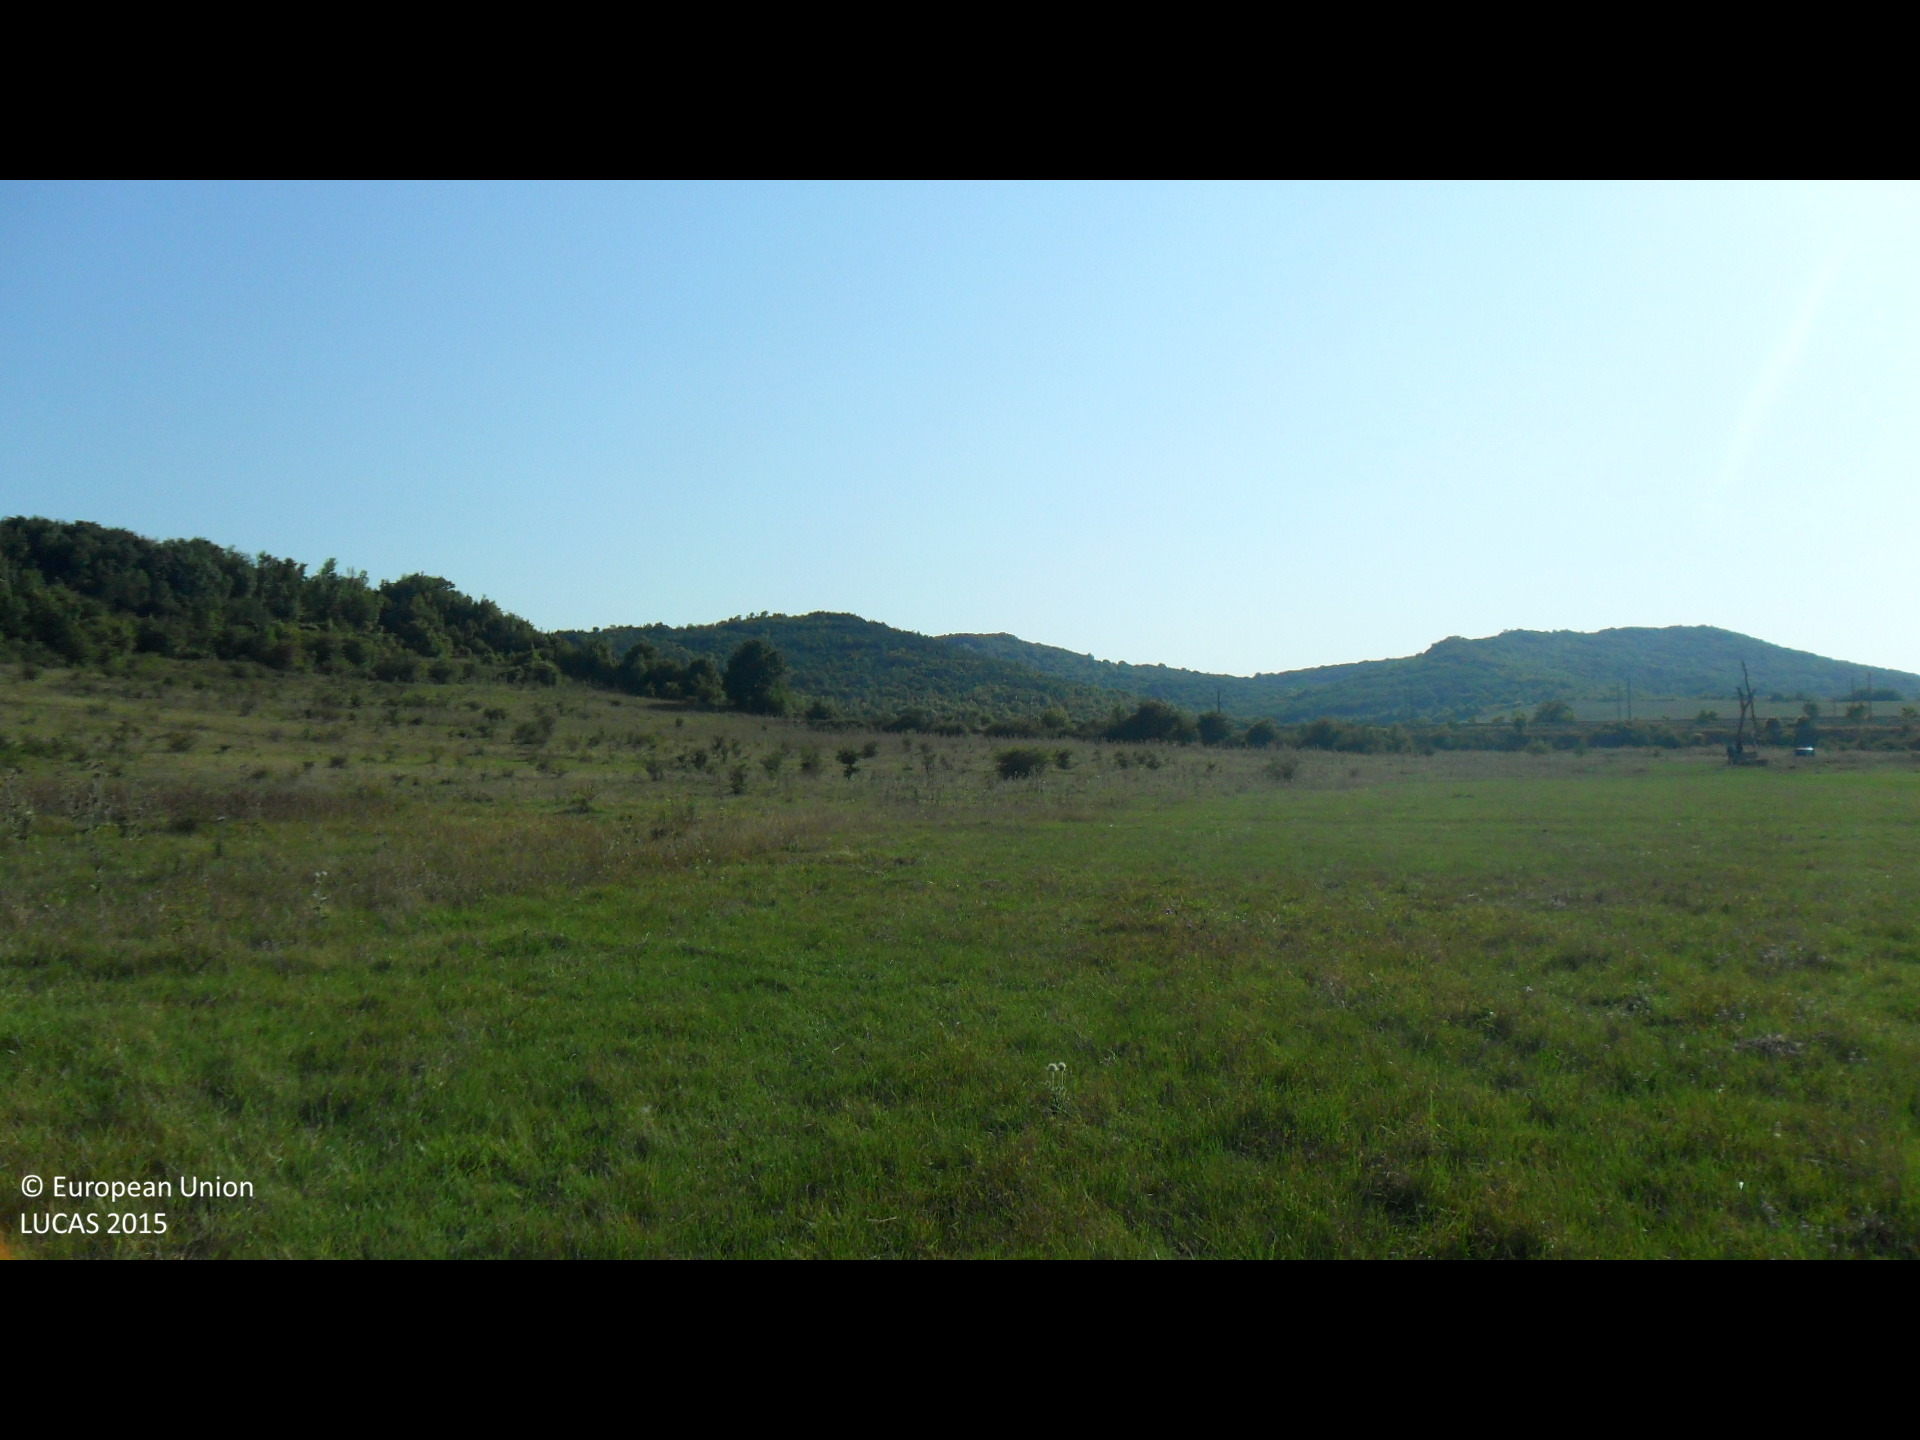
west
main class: Grassland
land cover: Grassland without tree/shrub cover
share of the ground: > 75 %
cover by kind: herbaceous plants 100 %
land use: Agriculture (excluding fallow land and kitchen gardens)
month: August
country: BG
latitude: 43.3185
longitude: 26.4643
